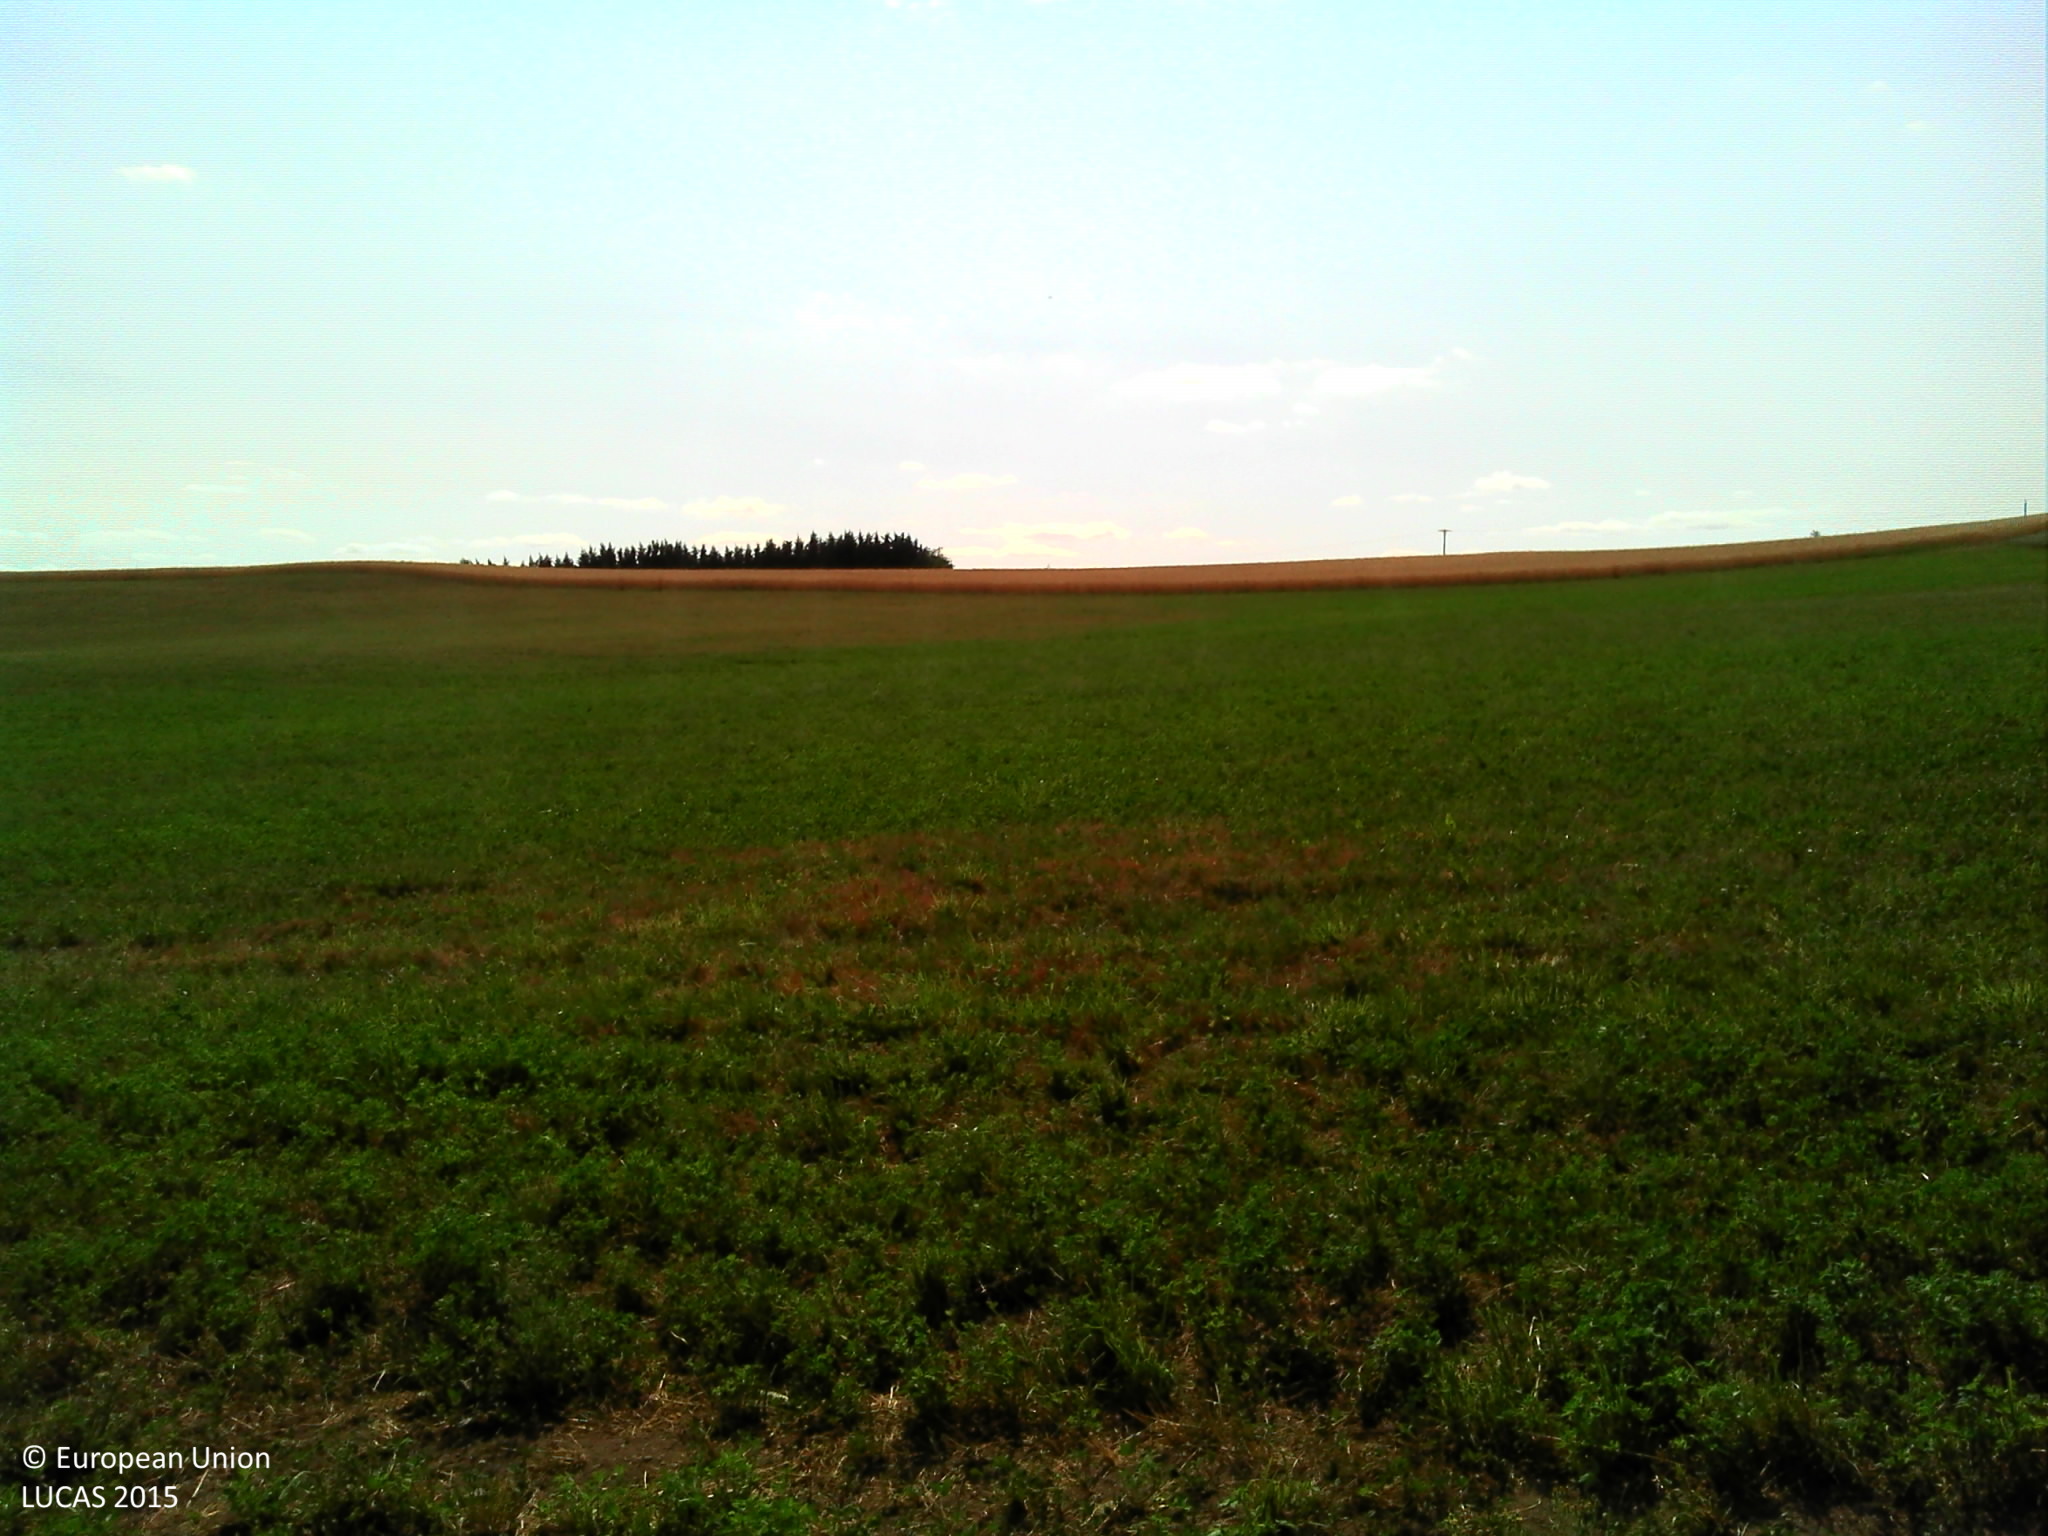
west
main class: Cropland
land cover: Lucerne
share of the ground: > 75 %
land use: Agriculture (excluding fallow land and kitchen gardens)
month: July
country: FR
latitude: 44.1399
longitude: 2.5917
